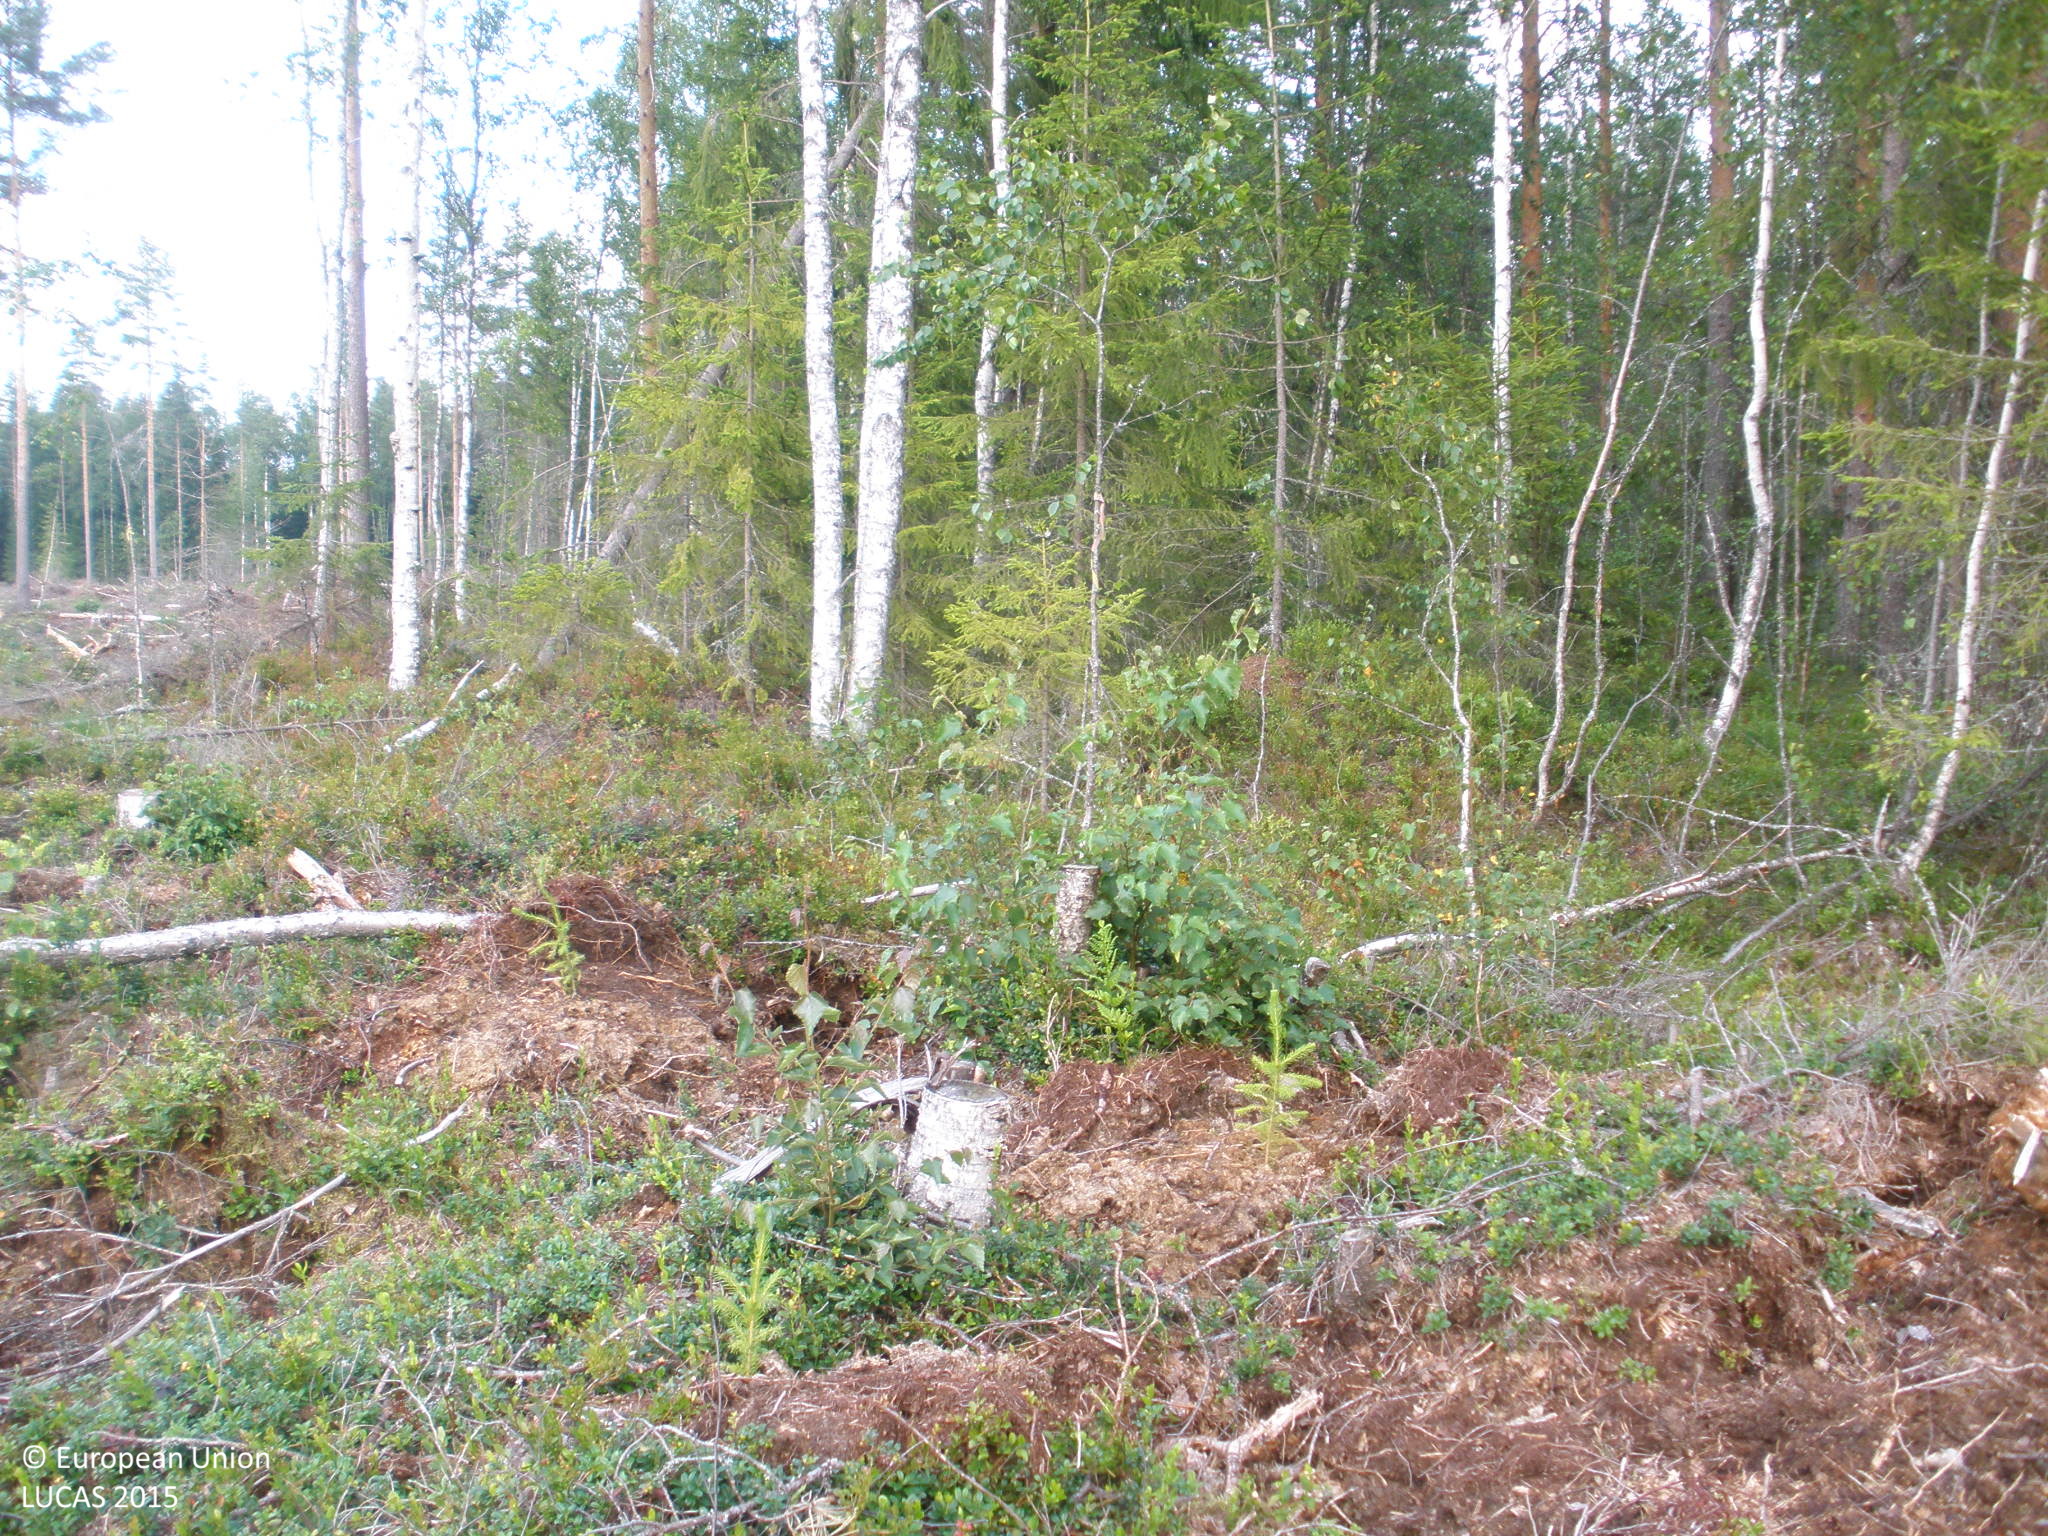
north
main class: Grassland
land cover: Grassland with sparse tree/shrub cover
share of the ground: 50 - 75 %
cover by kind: herbaceous plants 45 %, unconsolidated bare surface 25 %, consolidated bare surface 10 %, coniferous forest trees 5 %, shrubs 5 %
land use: Forestry
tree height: > 5 m
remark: Clear cut
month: August
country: FI
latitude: 60.6596
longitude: 24.2795
